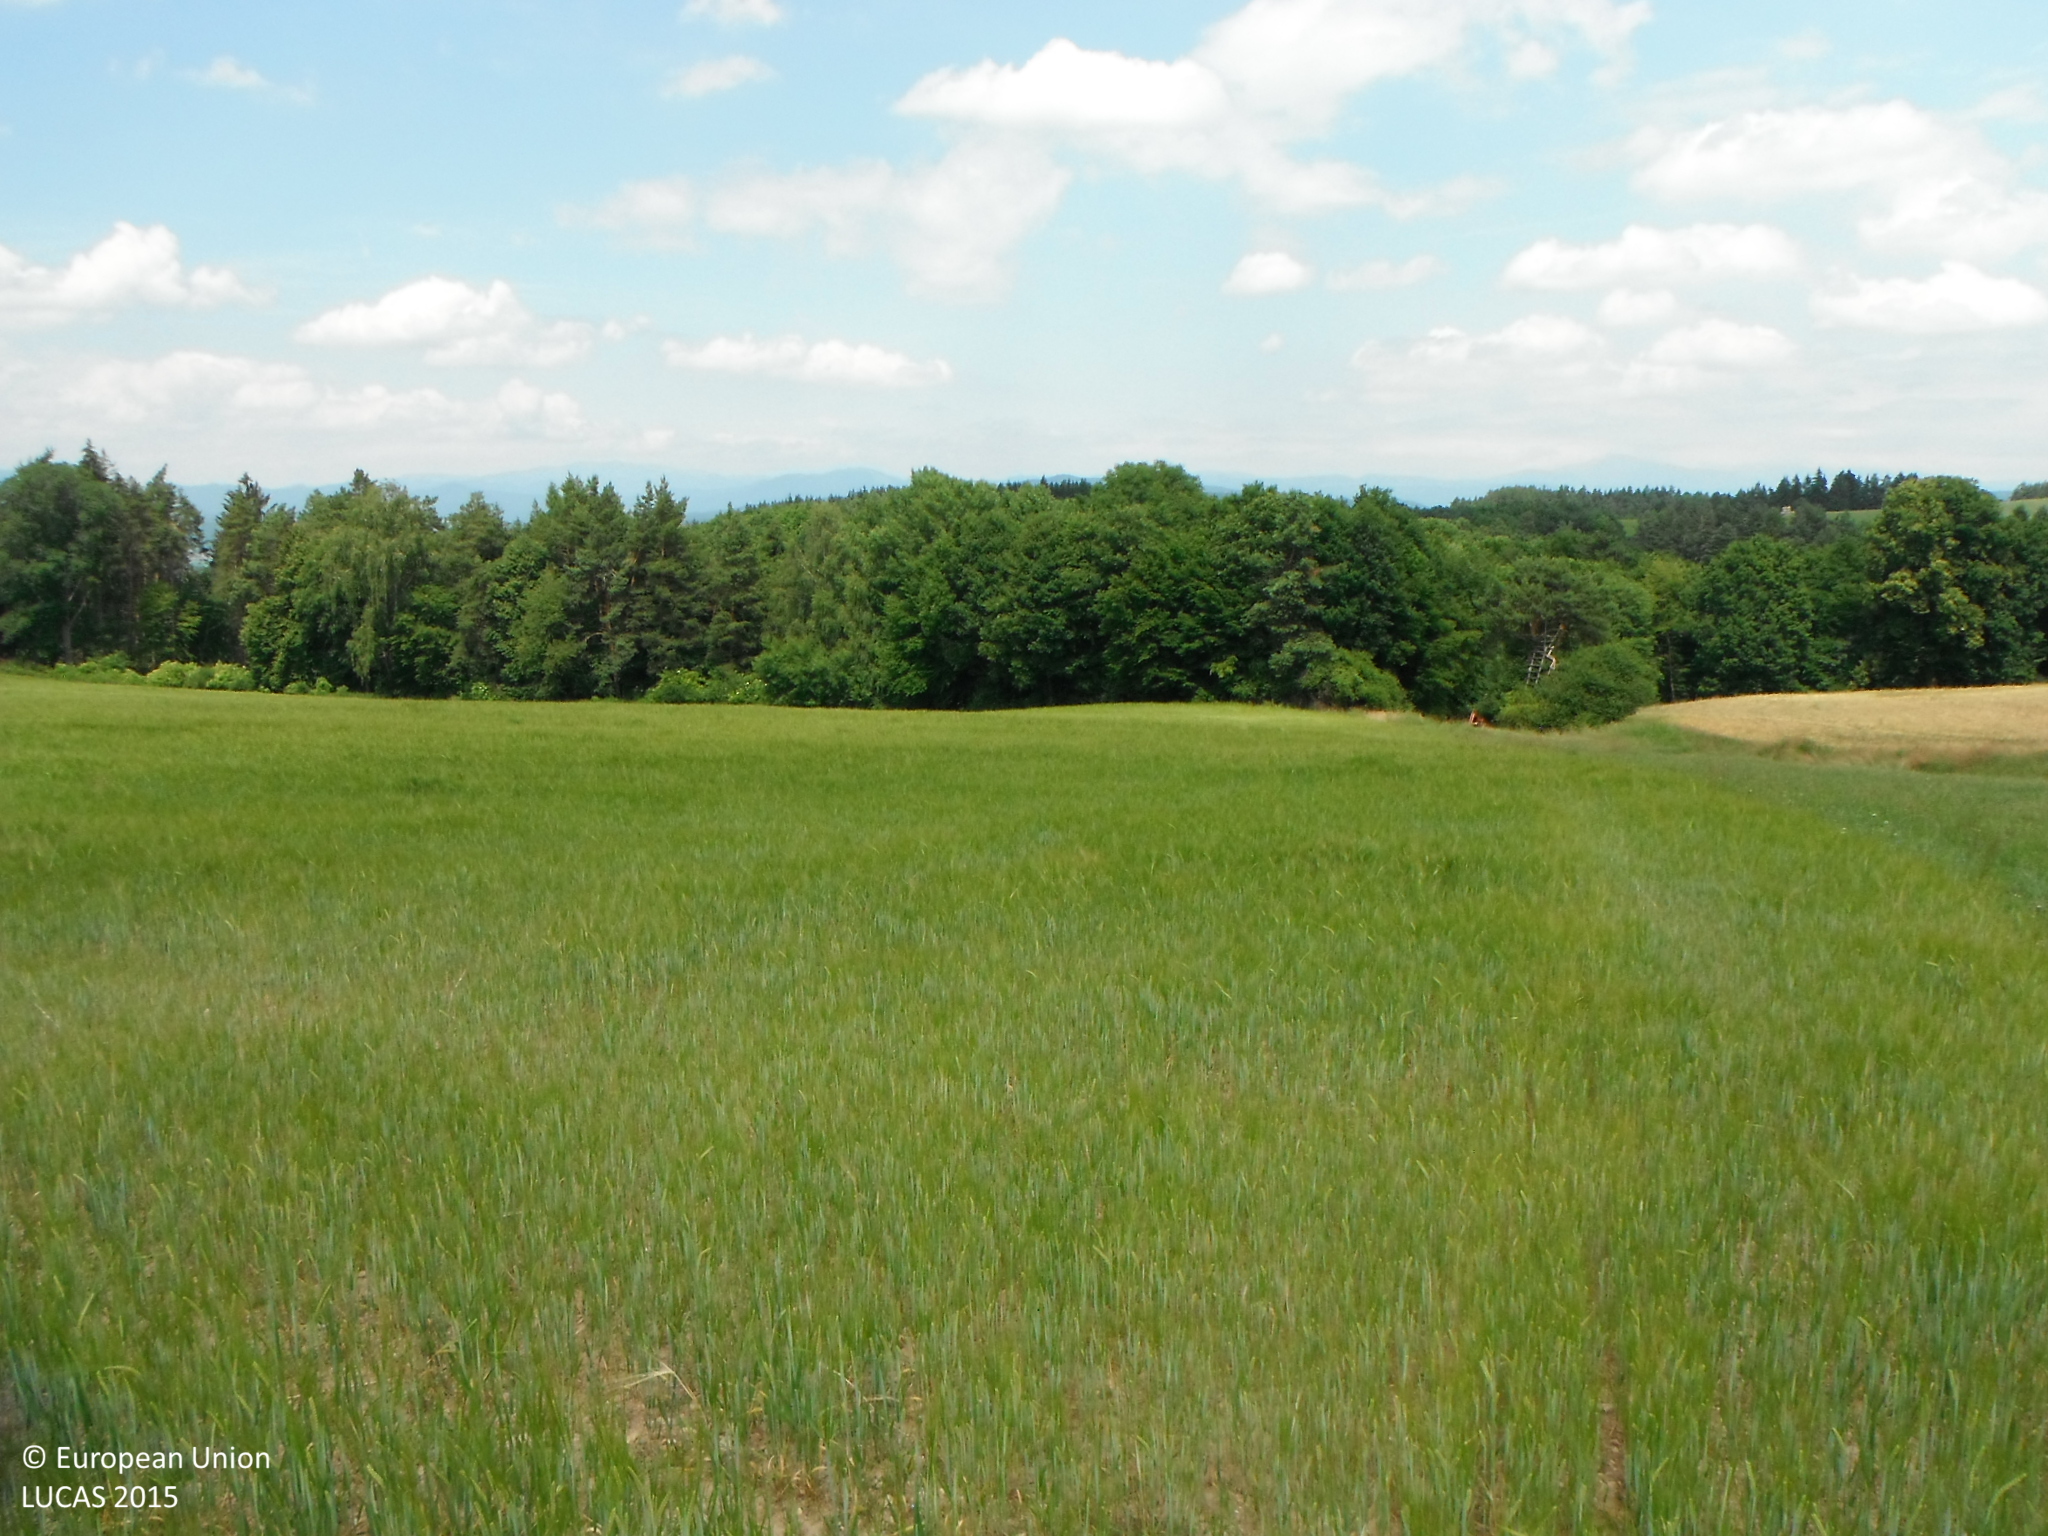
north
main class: Cropland
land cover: Barley
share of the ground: > 75 %
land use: Agriculture (excluding fallow land and kitchen gardens)
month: June
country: SK
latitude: 48.6185
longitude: 19.1790
